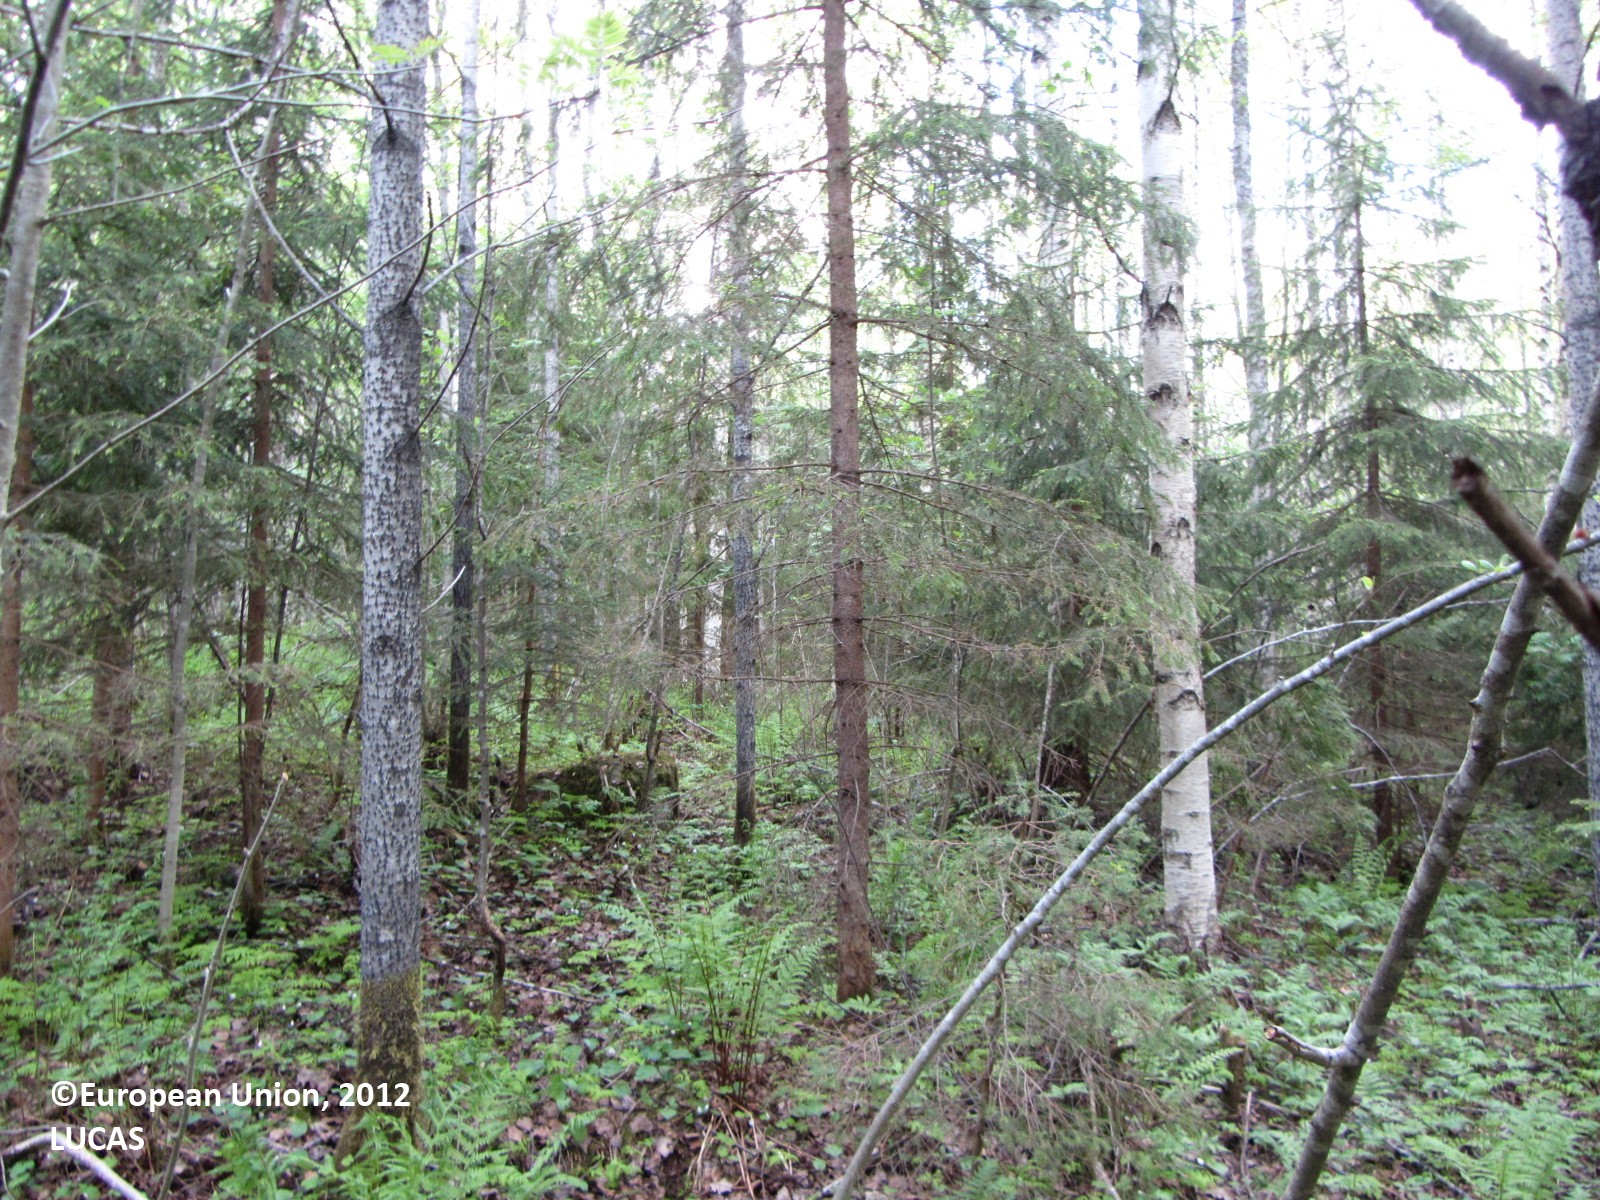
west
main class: Woodland
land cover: Spruce dominated mixed woodland
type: boreal forest
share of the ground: > 75 %
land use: Forestry
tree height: > 5 m
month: May
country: FI
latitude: 62.2788
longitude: 25.3530
